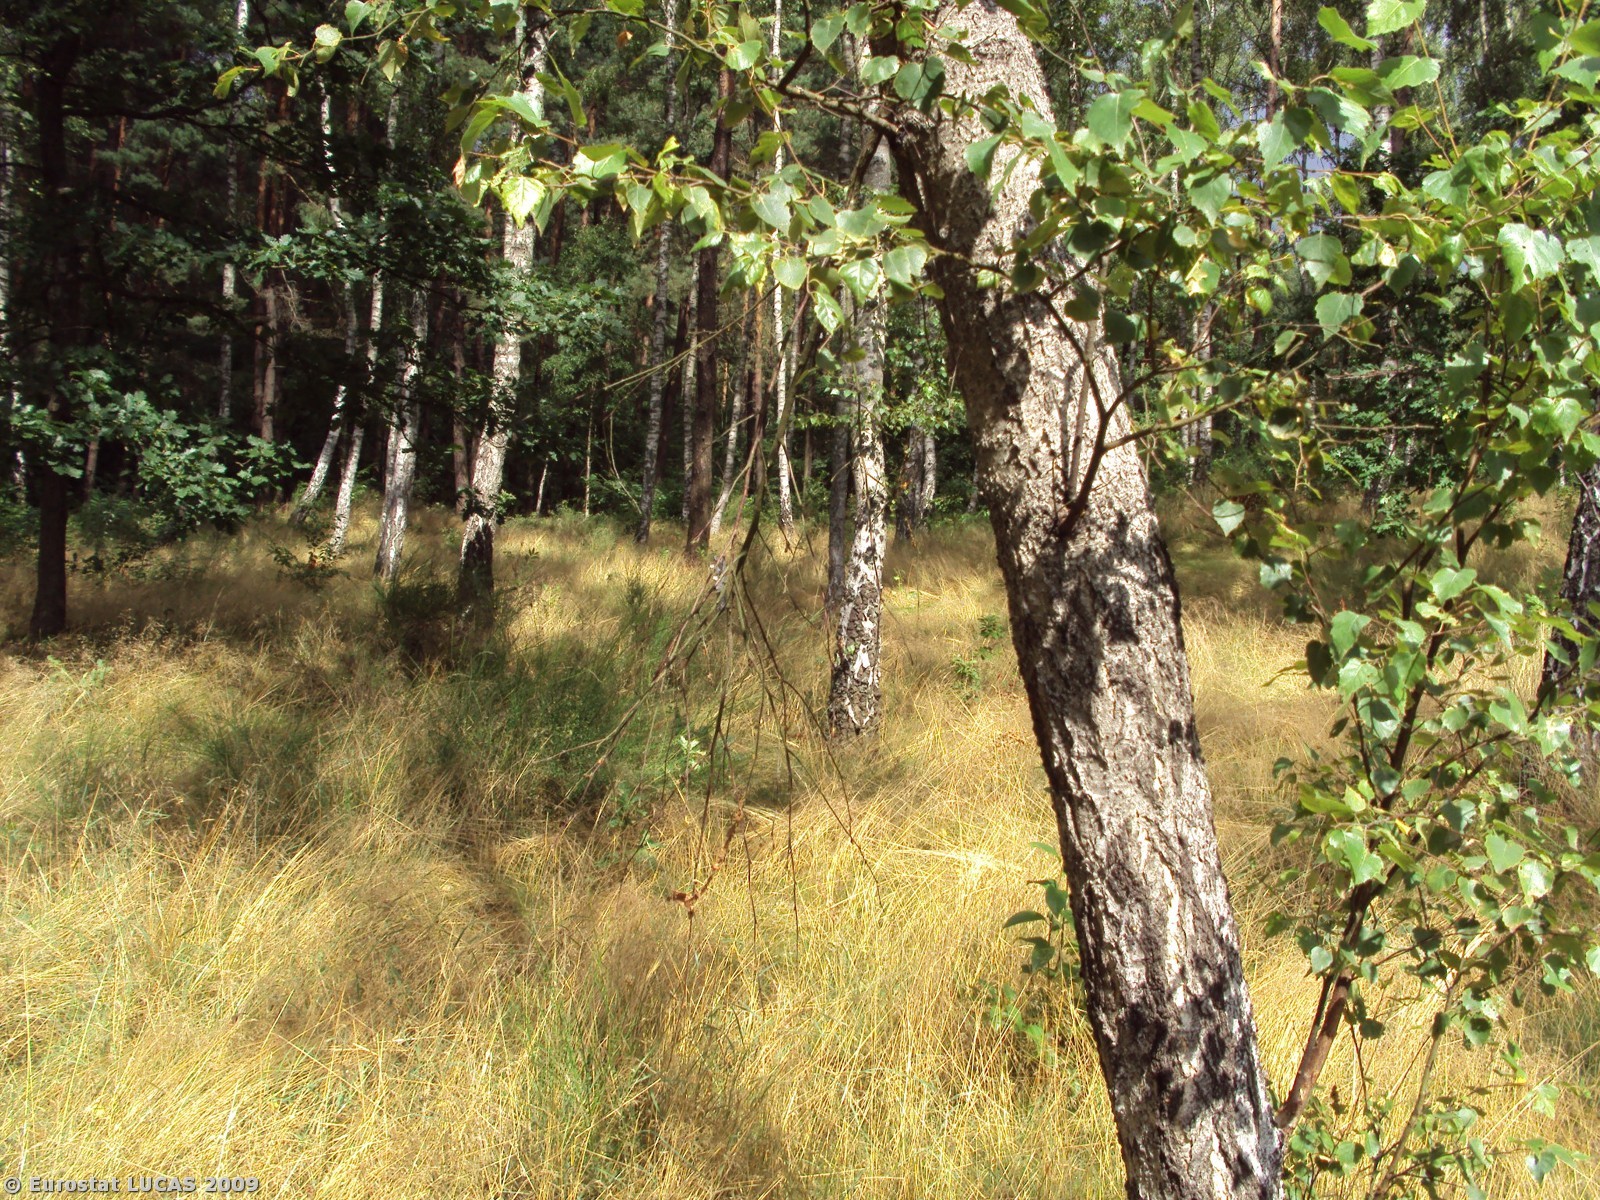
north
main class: Woodland
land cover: Broadleaved woodland
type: mesophytic deciduous forest
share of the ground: > 75 %
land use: Forestry
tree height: > 5 m
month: August
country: PL
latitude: 53.4881
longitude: 15.9881
